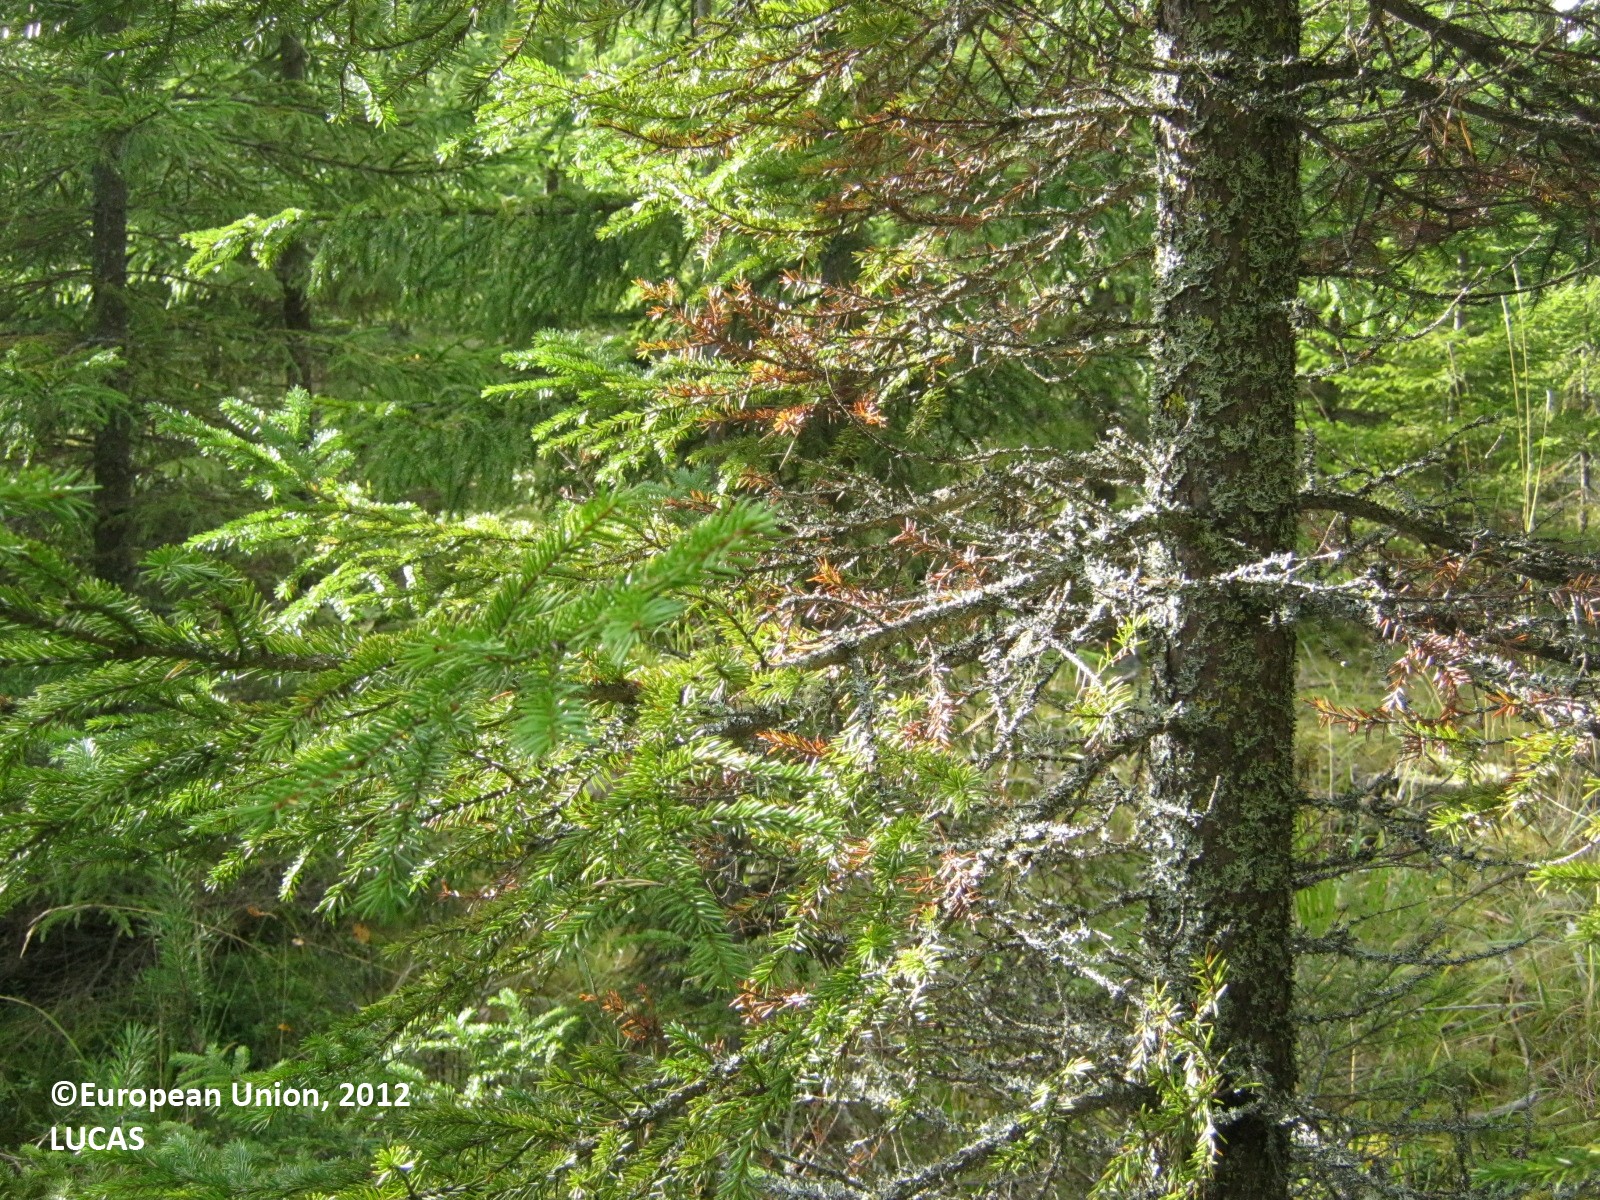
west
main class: Woodland
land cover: Spruce dominated coniferous woodland
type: boreal forest
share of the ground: > 75 %
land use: Forestry
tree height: > 5 m
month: September
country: FI
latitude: 62.2526
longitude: 28.9143
